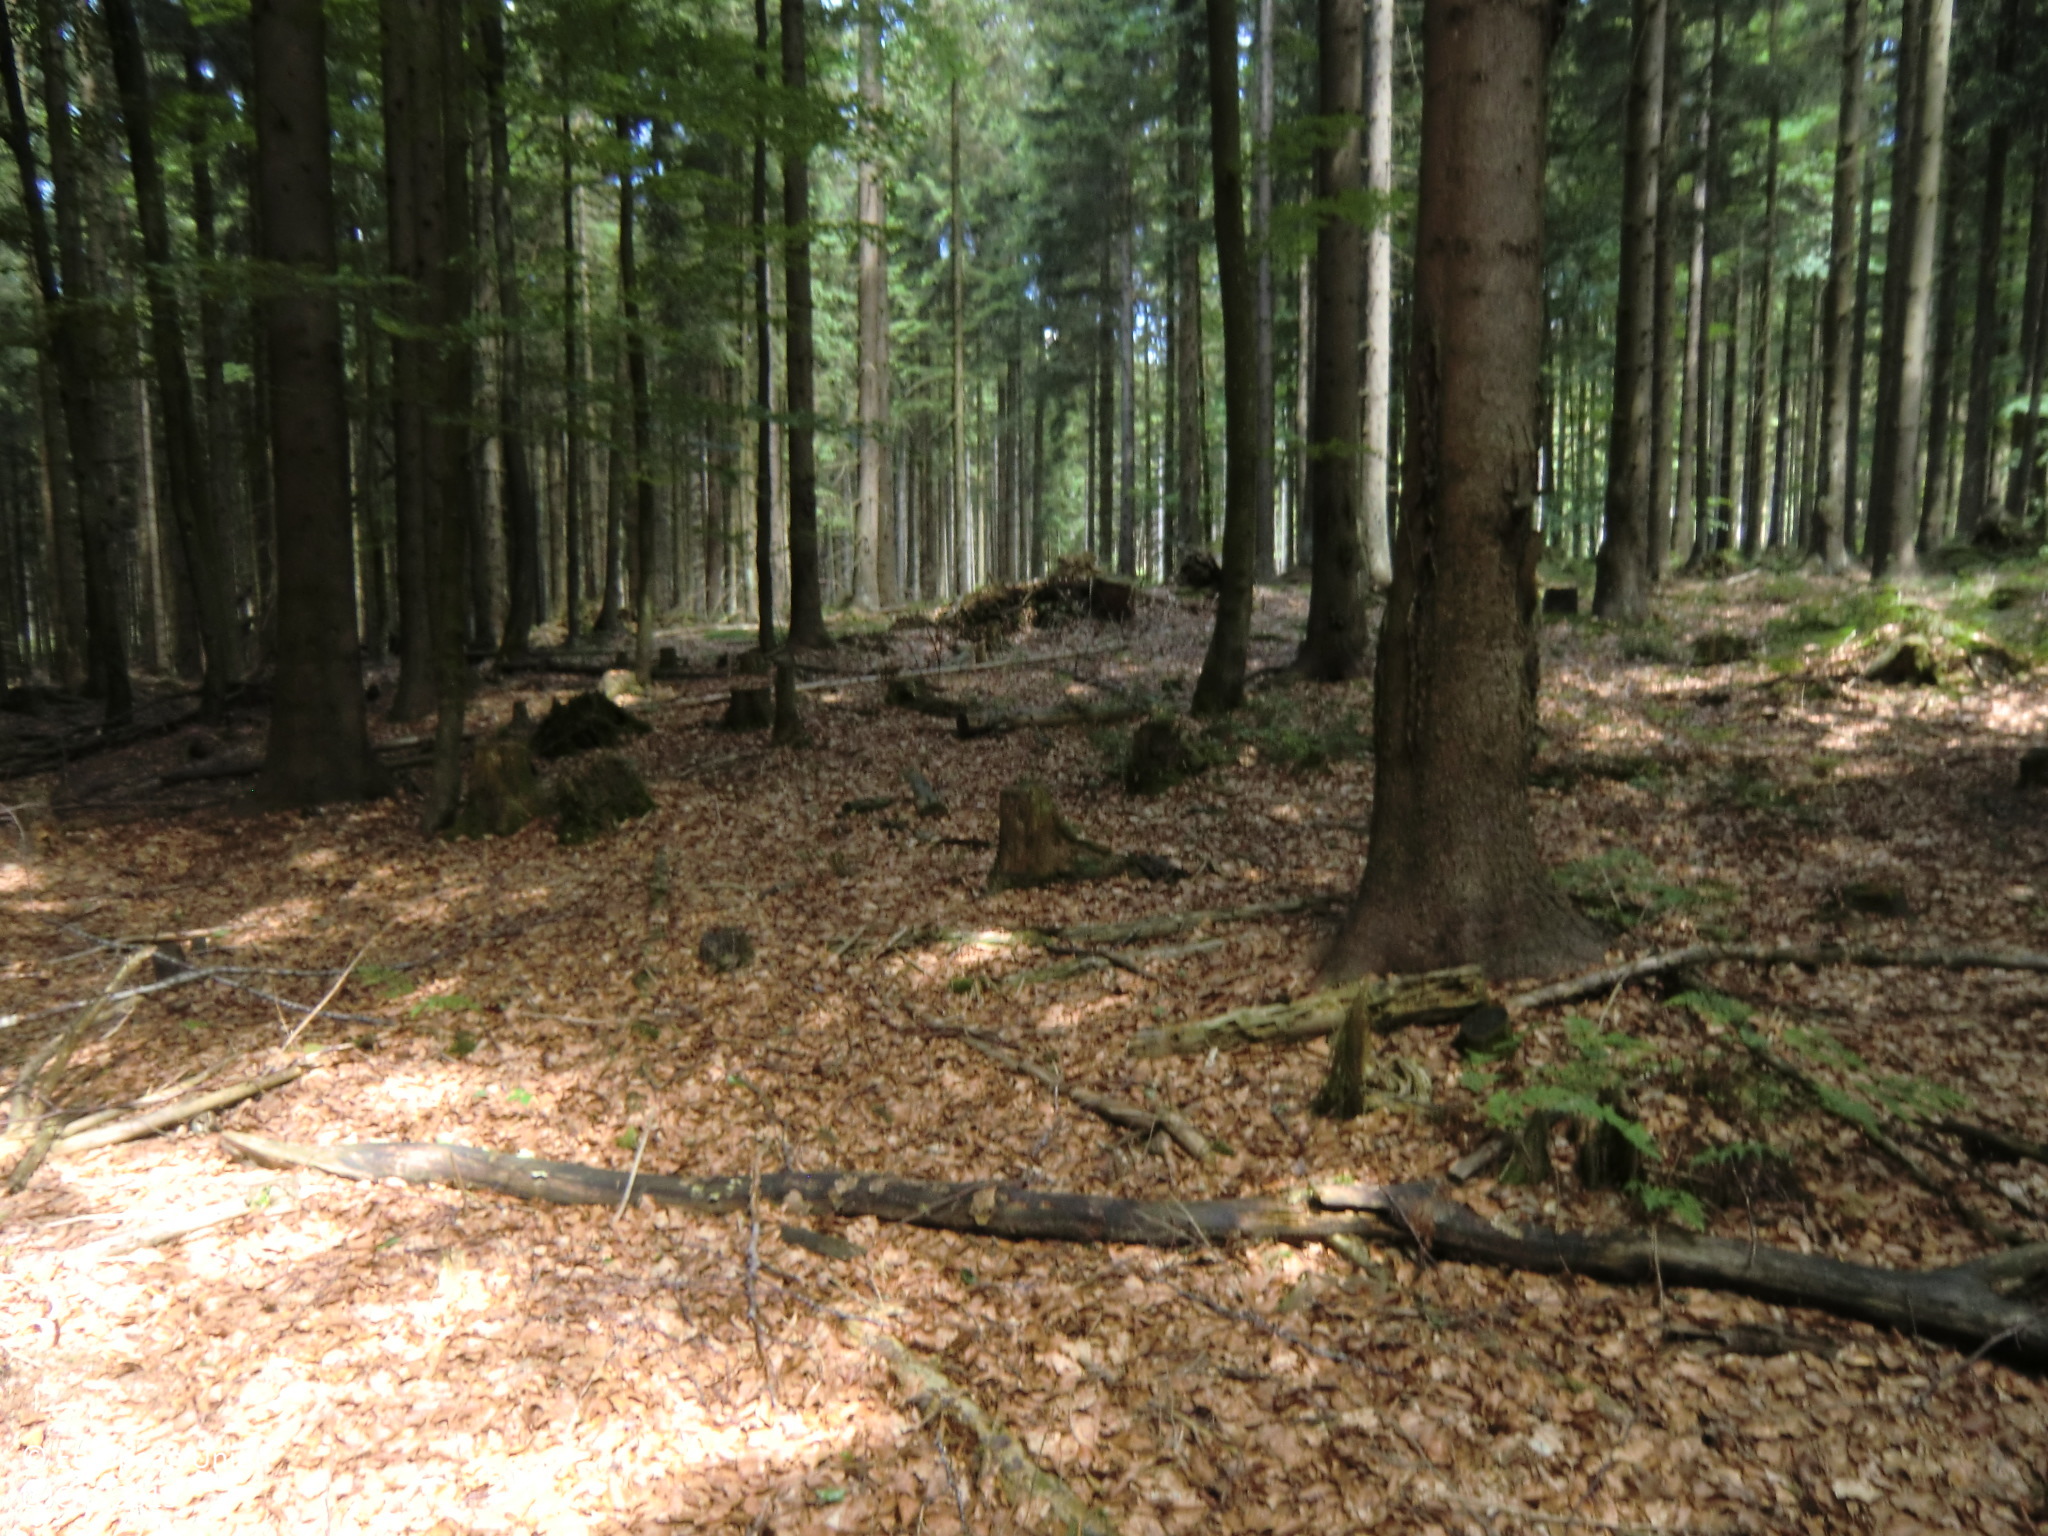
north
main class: Woodland
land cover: Spruce dominated mixed woodland
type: hemiboreal forest and nemoral coniferous forest and mixed broadleaved-coniferous forest
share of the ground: > 75 %
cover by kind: coniferous forest trees 45 %, broadleaved forest trees 45 %, consolidated bare surface 10 %
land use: Forestry
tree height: > 5 m
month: June
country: AT
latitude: 48.3633
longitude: 14.9819
